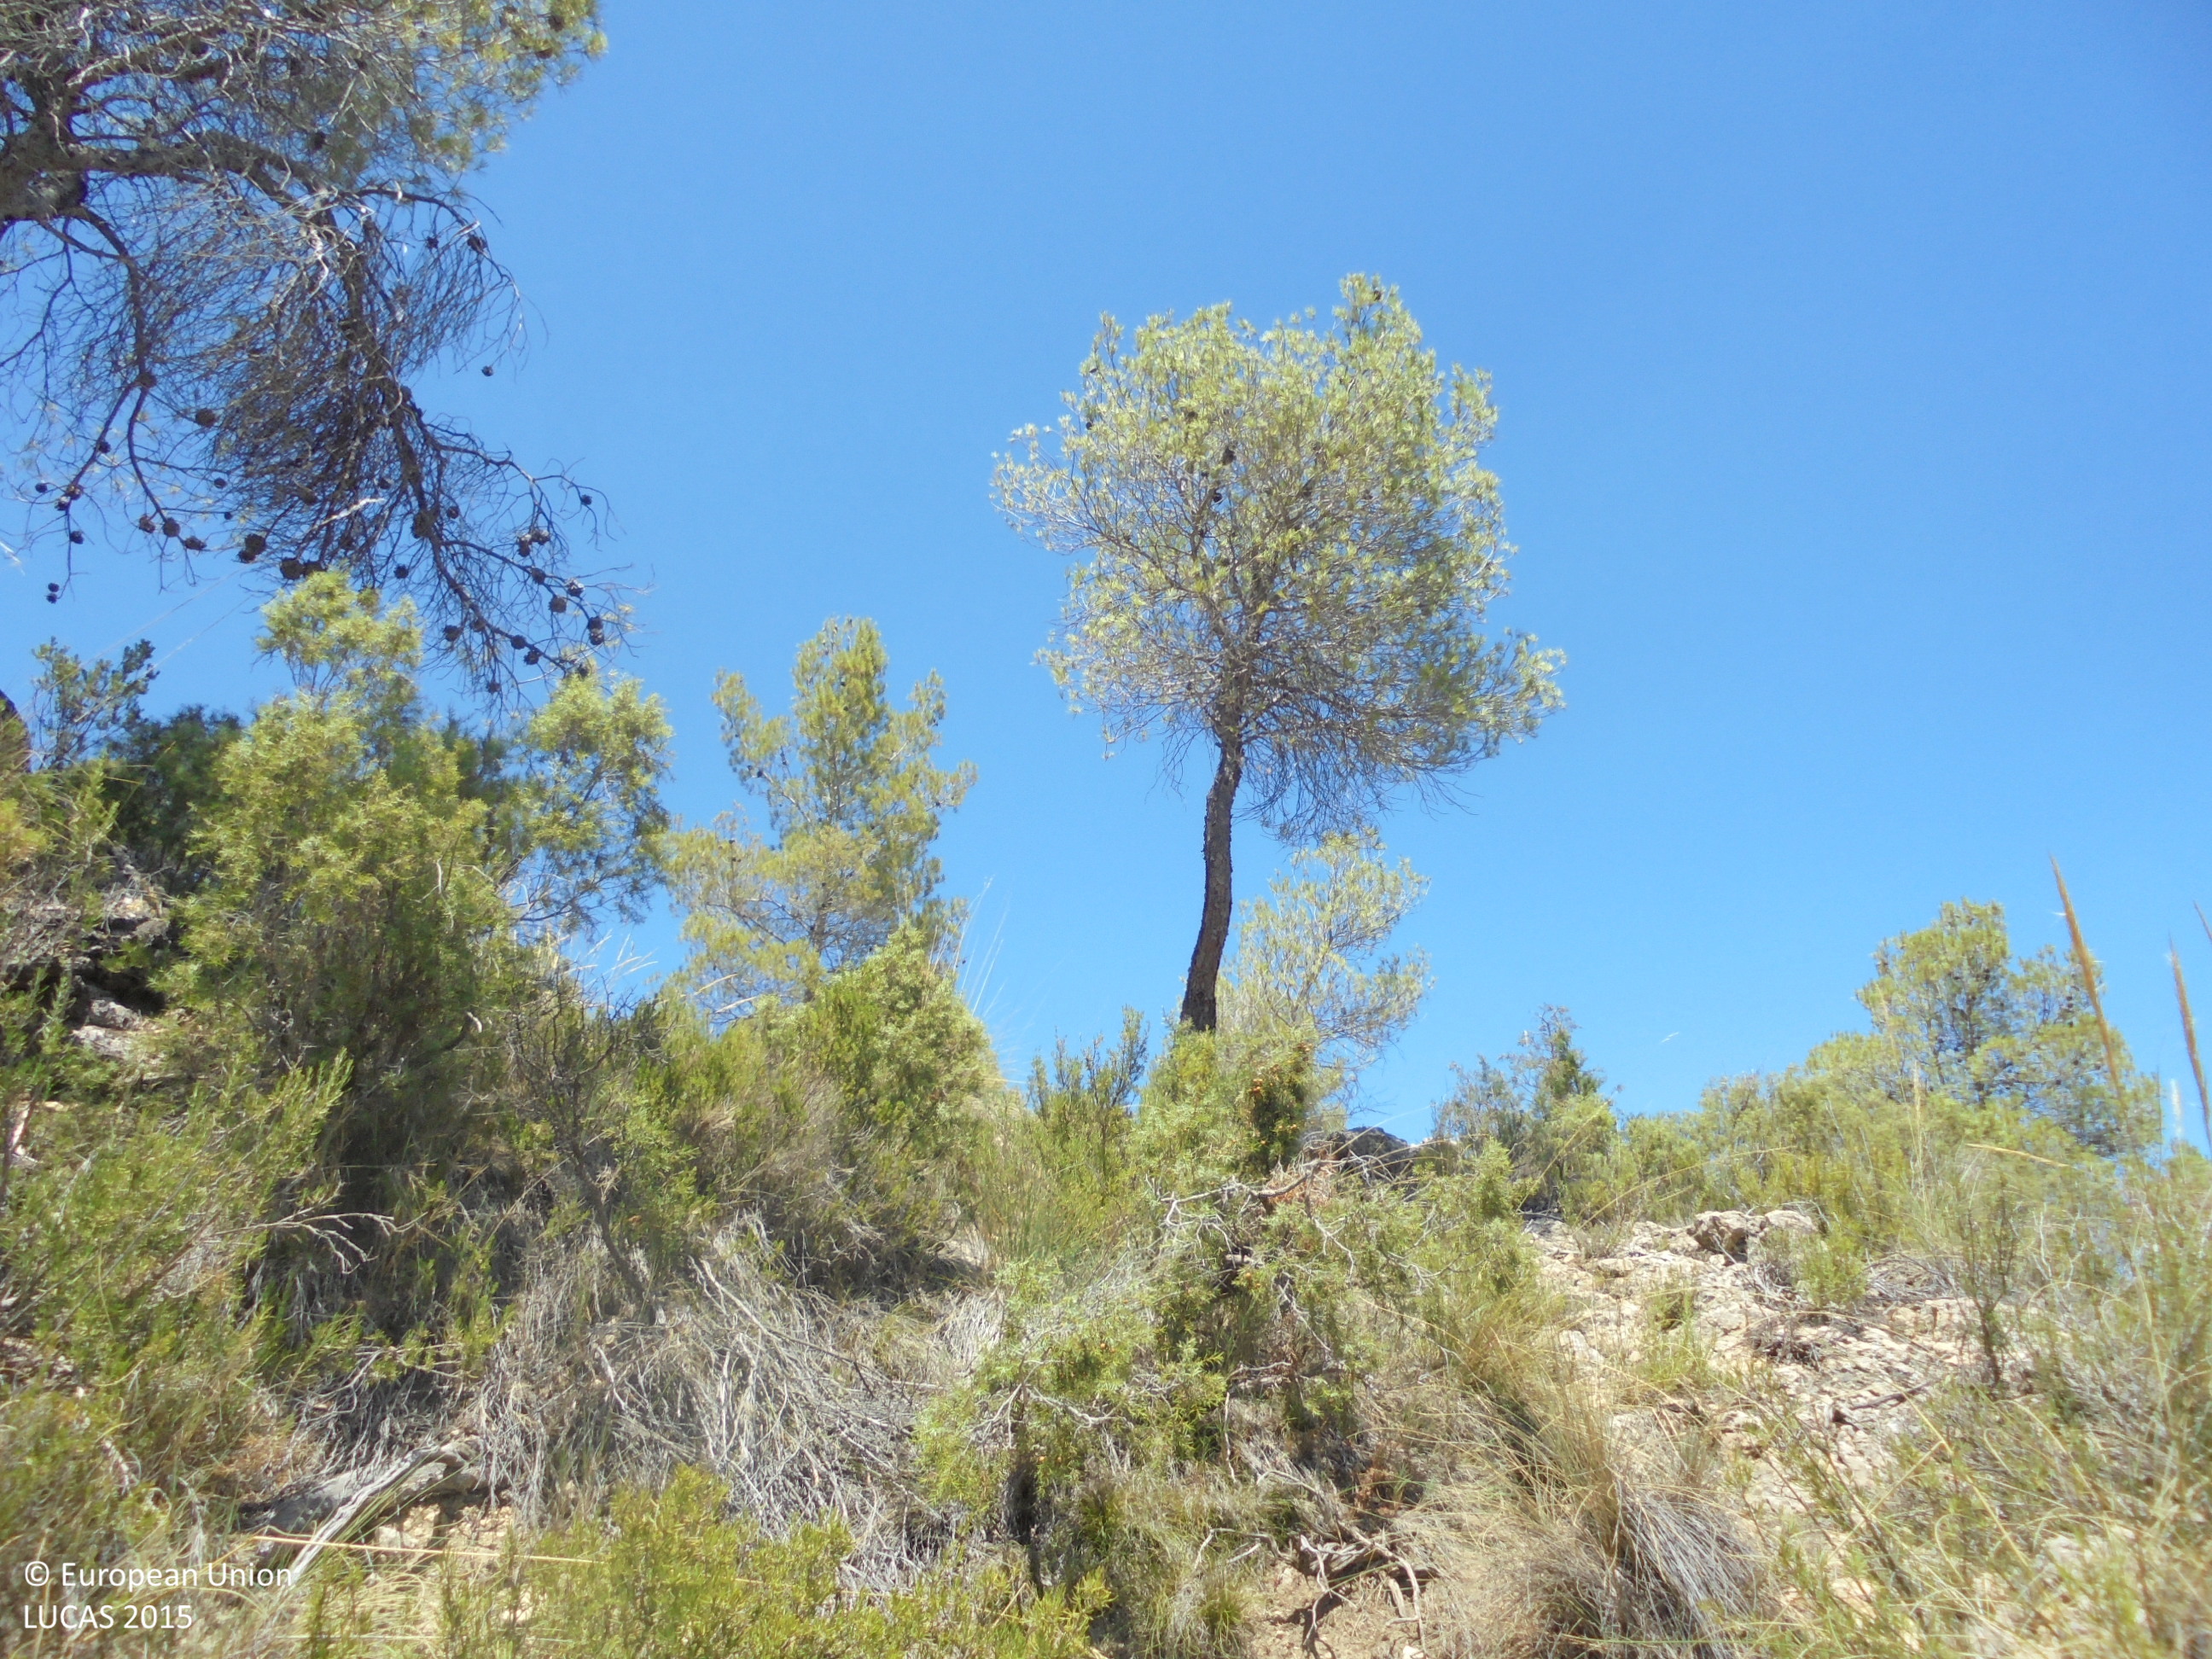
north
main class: Woodland
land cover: Pine dominated coniferous woodland
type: coniferous forest of the mediterranean region
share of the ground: 25 - 50 %
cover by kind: shrubs 50 %, coniferous forest trees 30 %, consolidated bare surface 10 %, unconsolidated bare surface 10 %
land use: Semi-natural and natural areas not in use
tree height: > 5 m
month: July
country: ES
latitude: 38.9669
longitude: -1.0400
